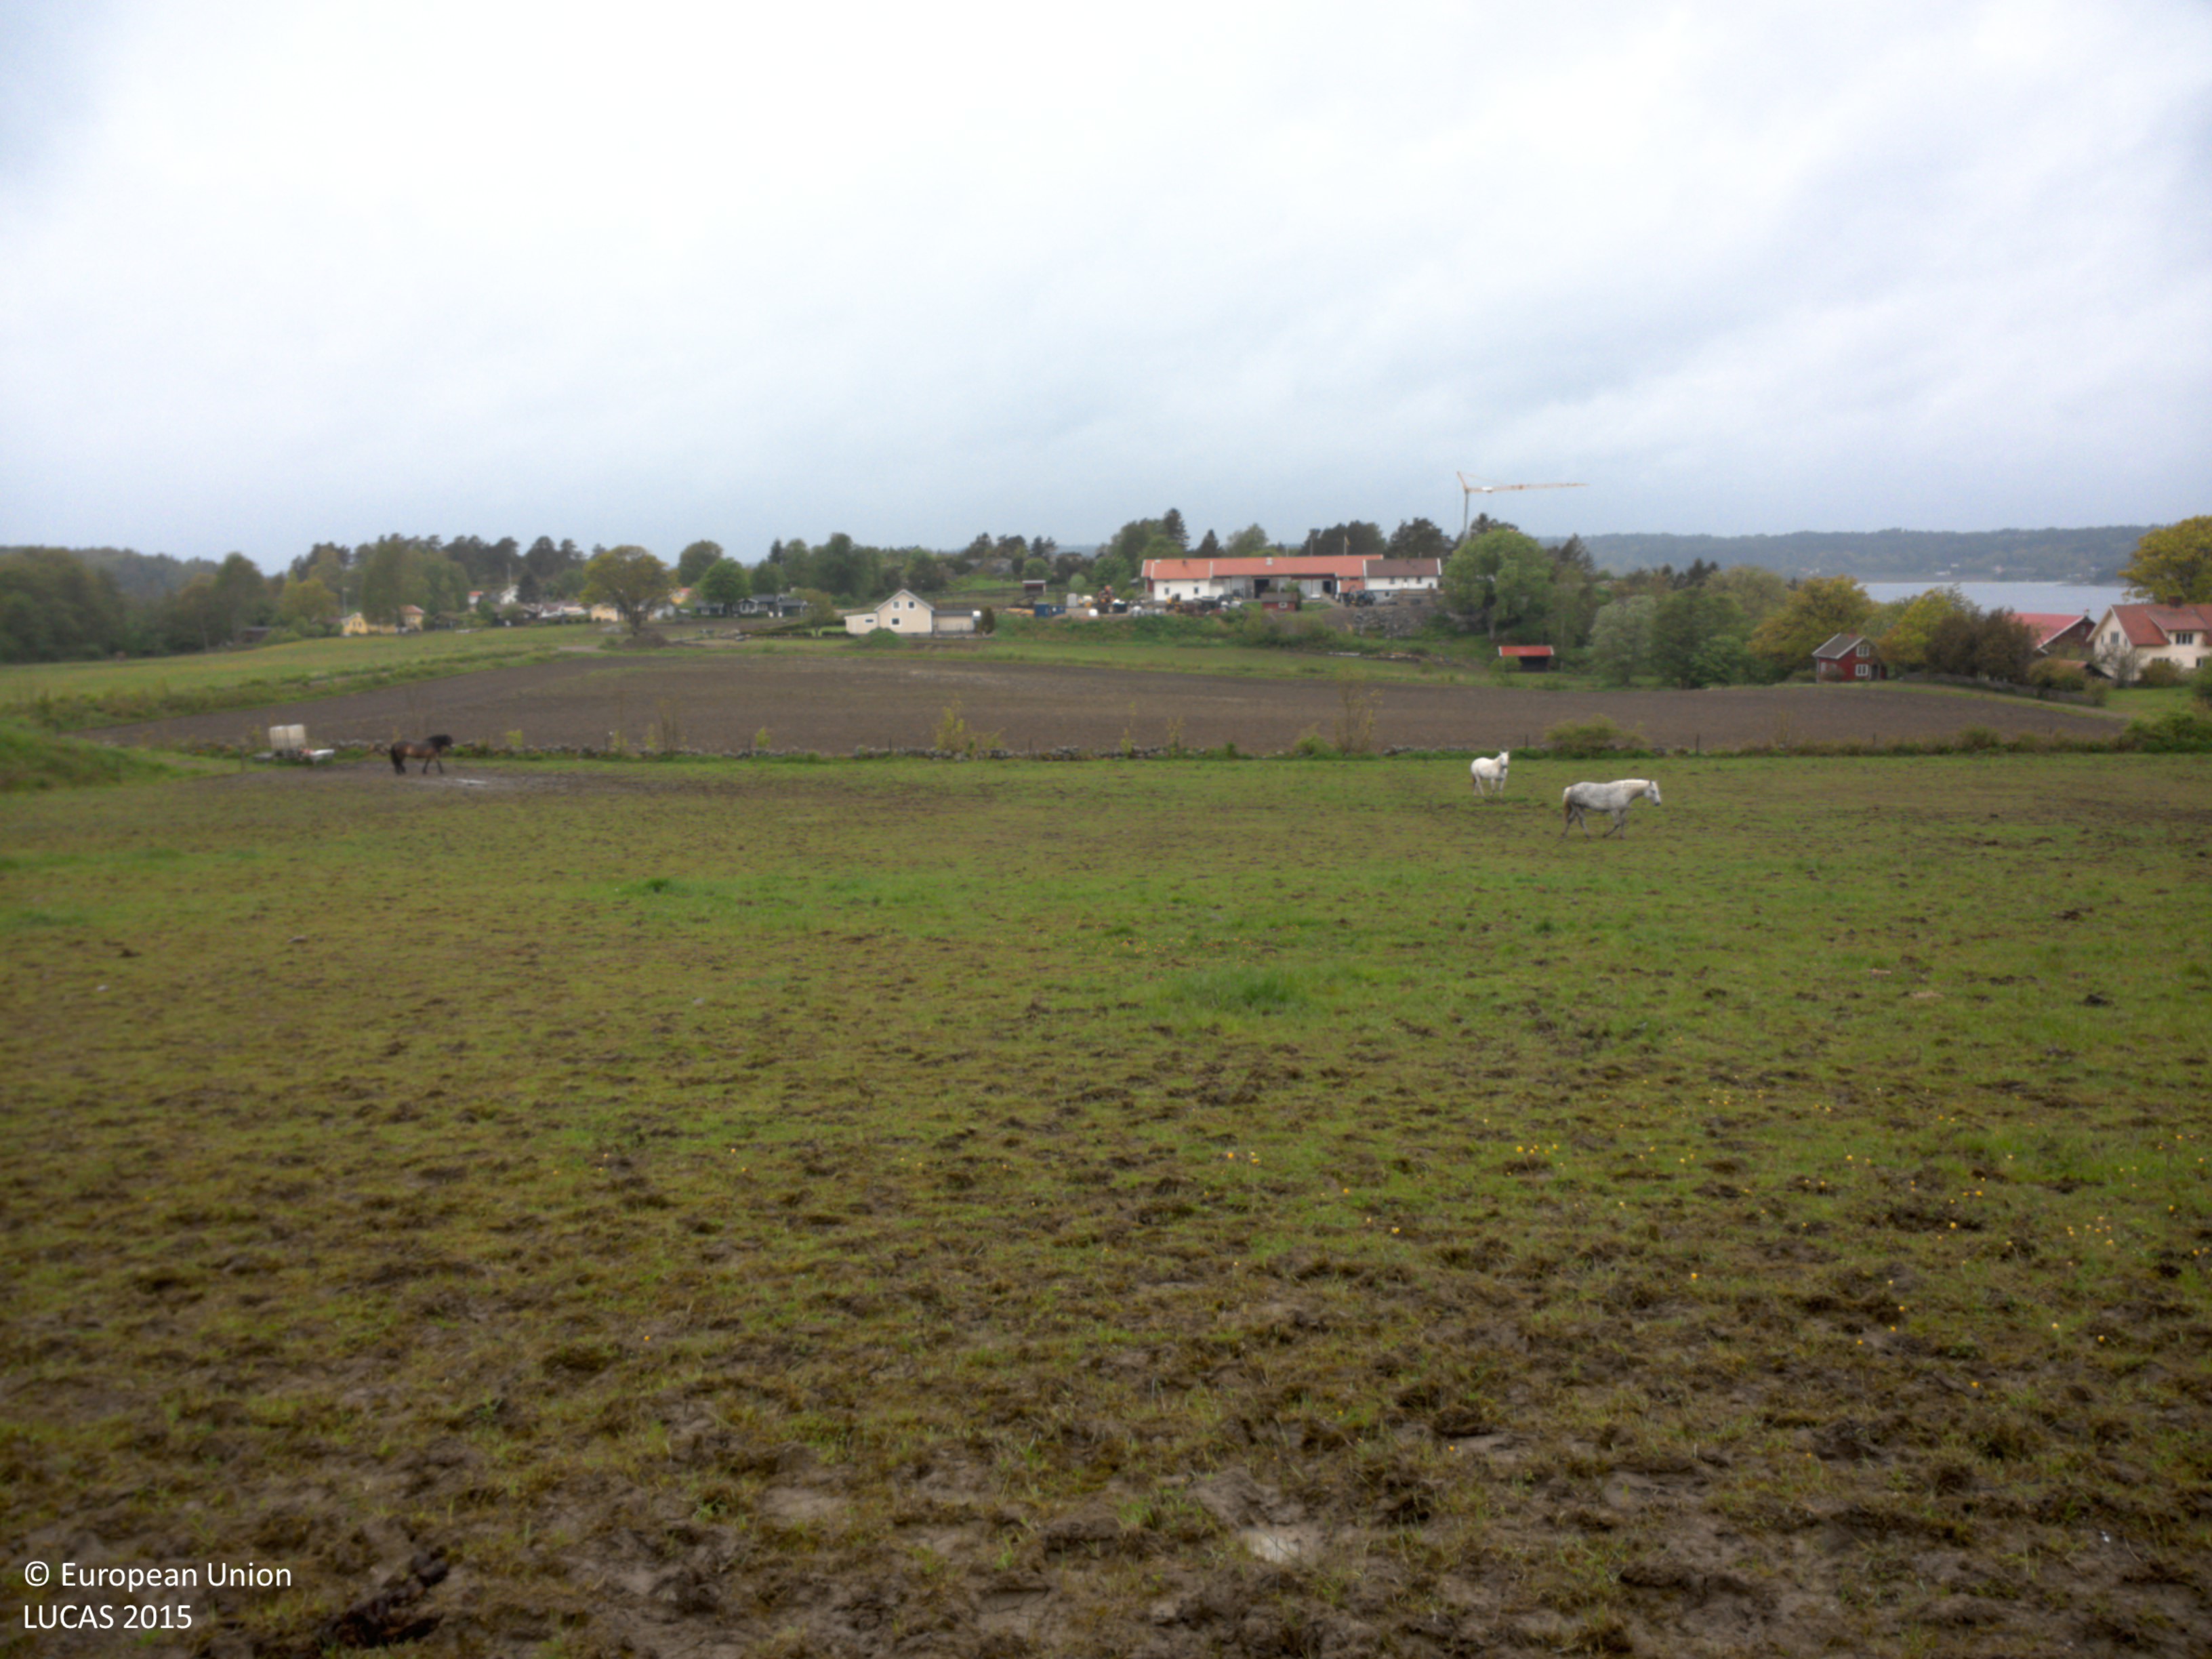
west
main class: Grassland
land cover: Grassland without tree/shrub cover
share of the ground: > 75 %
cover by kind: herbaceous plants 100 %
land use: Agriculture (excluding fallow land and kitchen gardens)
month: May
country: SE
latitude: 58.3361
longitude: 11.5852
